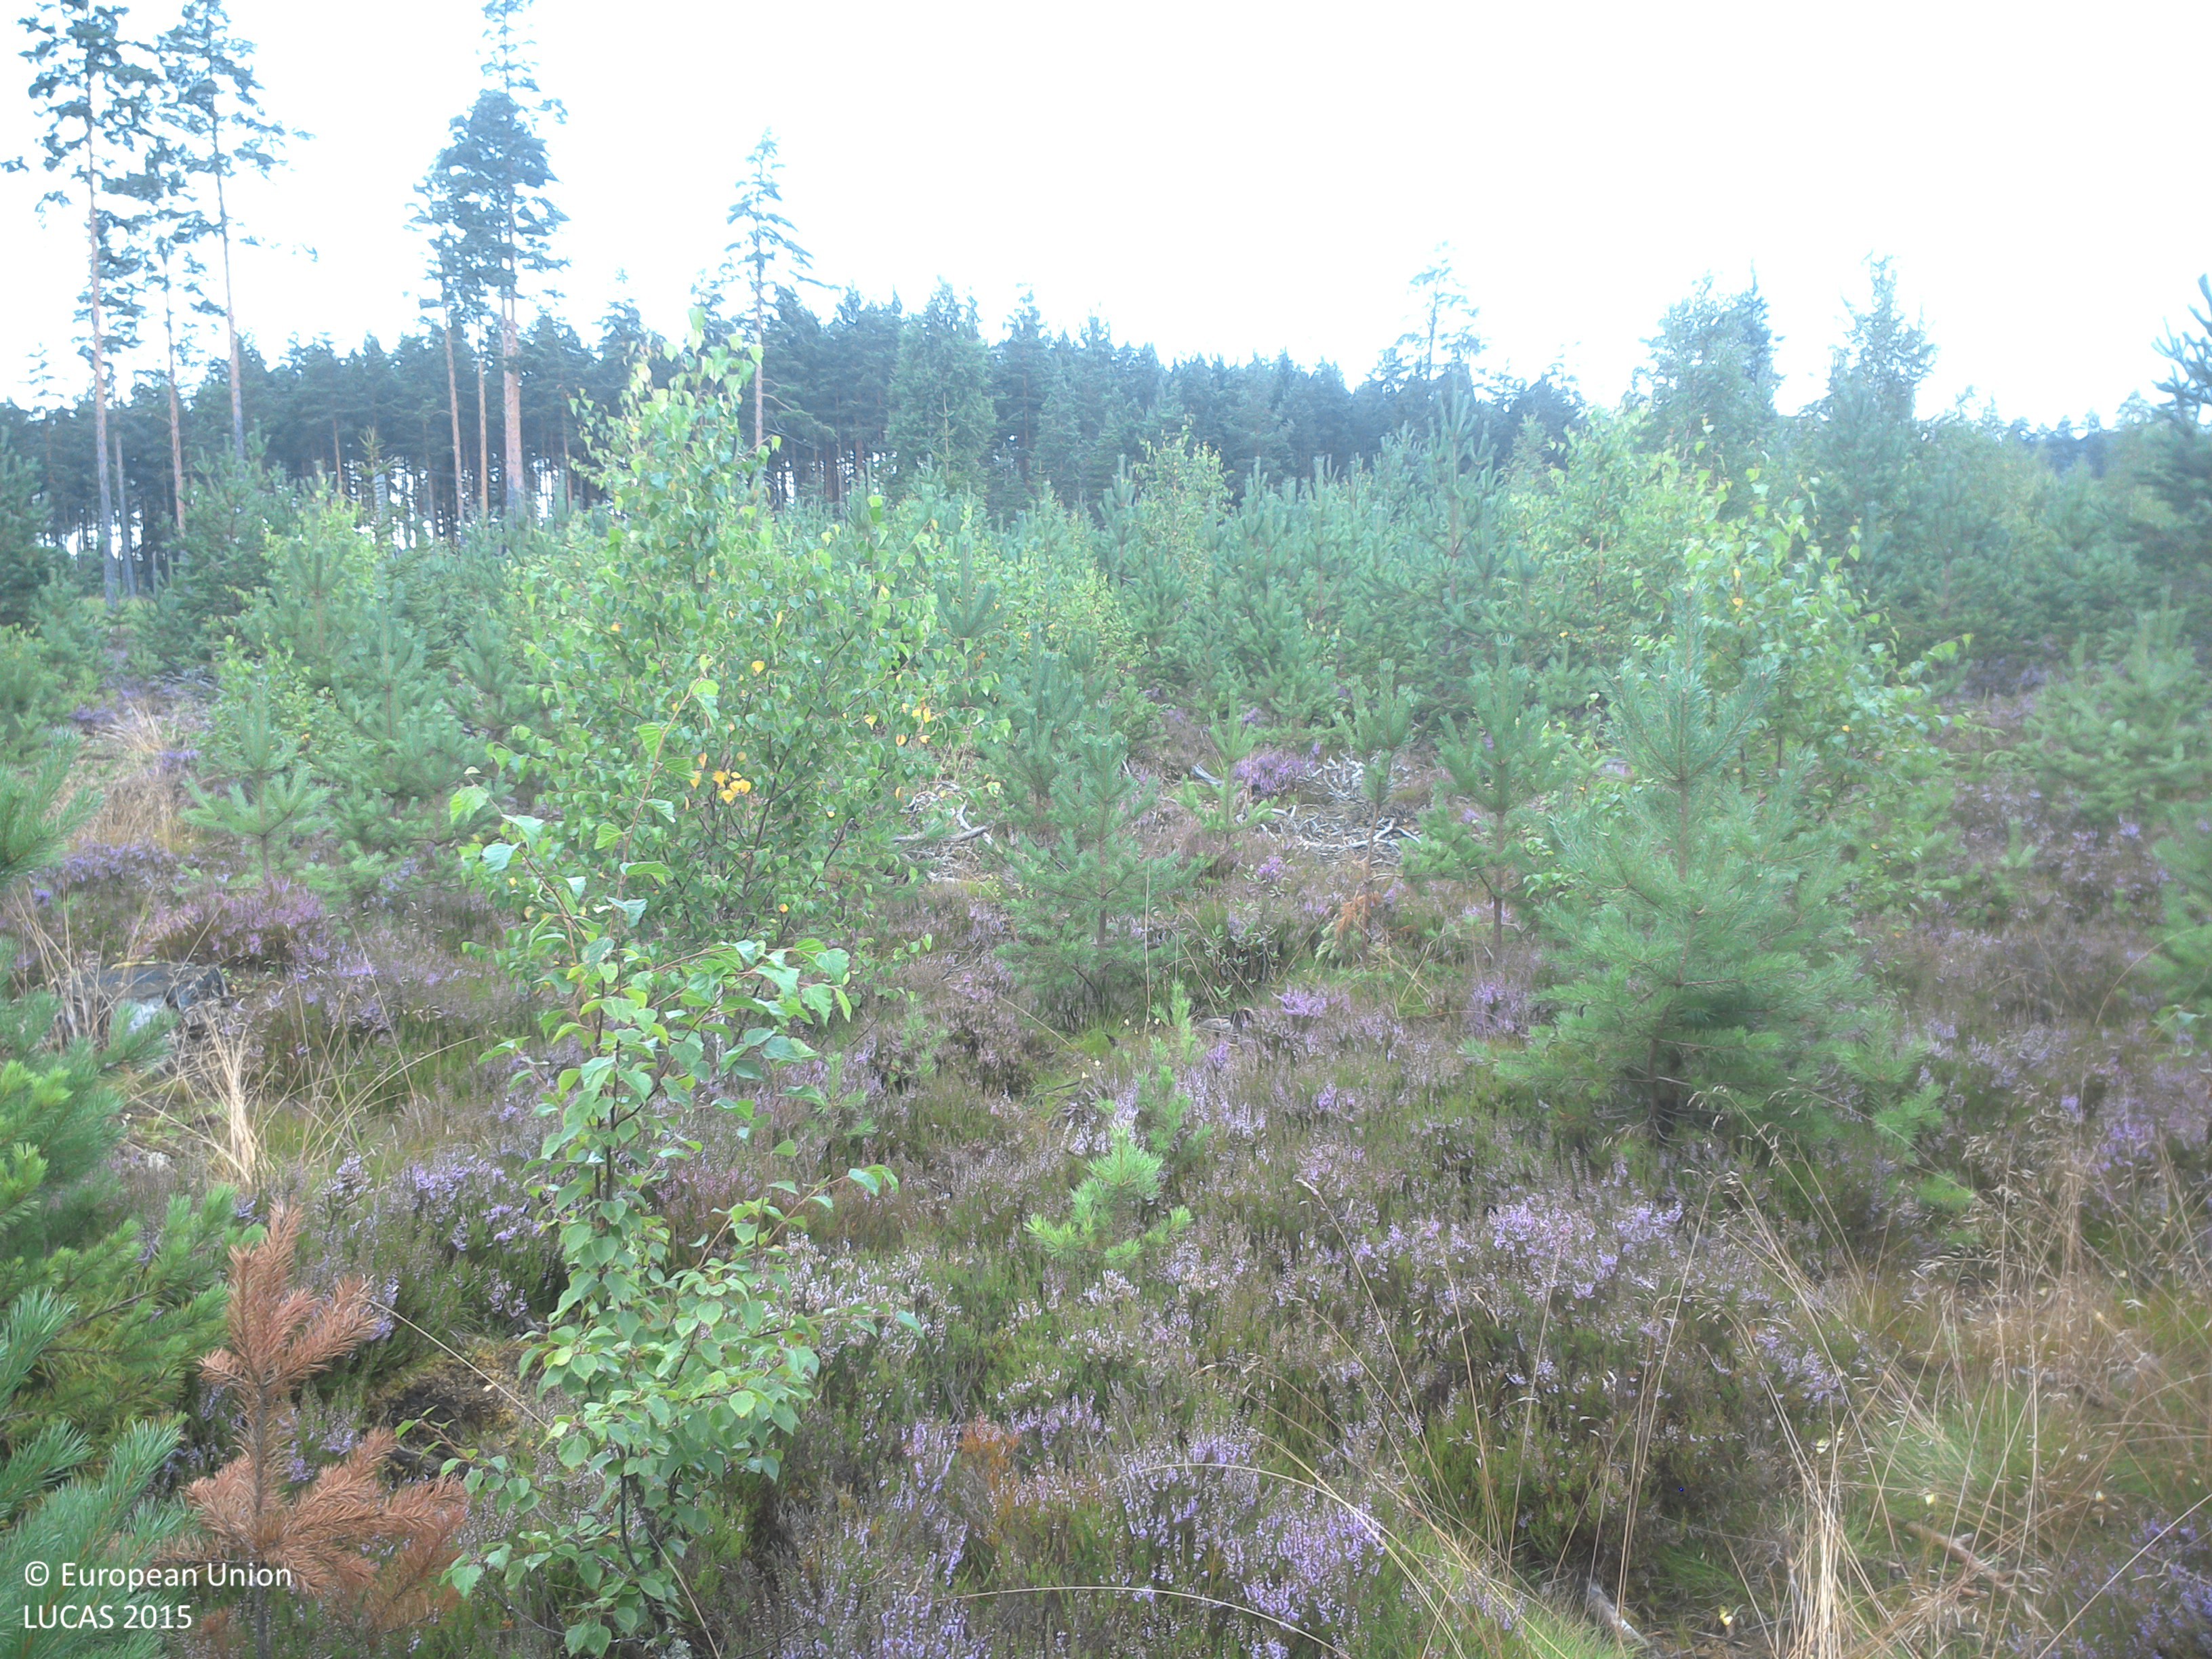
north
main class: Woodland
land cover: Pine dominated mixed woodland
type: boreal forest
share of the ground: 25 - 50 %
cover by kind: herbaceous plants 40 %, coniferous forest trees 25 %, shrubs 20 %, broadleaved forest trees 10 %, lichens and mosses 5 %
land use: Forestry
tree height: < 5 m
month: August
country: SE
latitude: 57.7992
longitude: 15.5316
